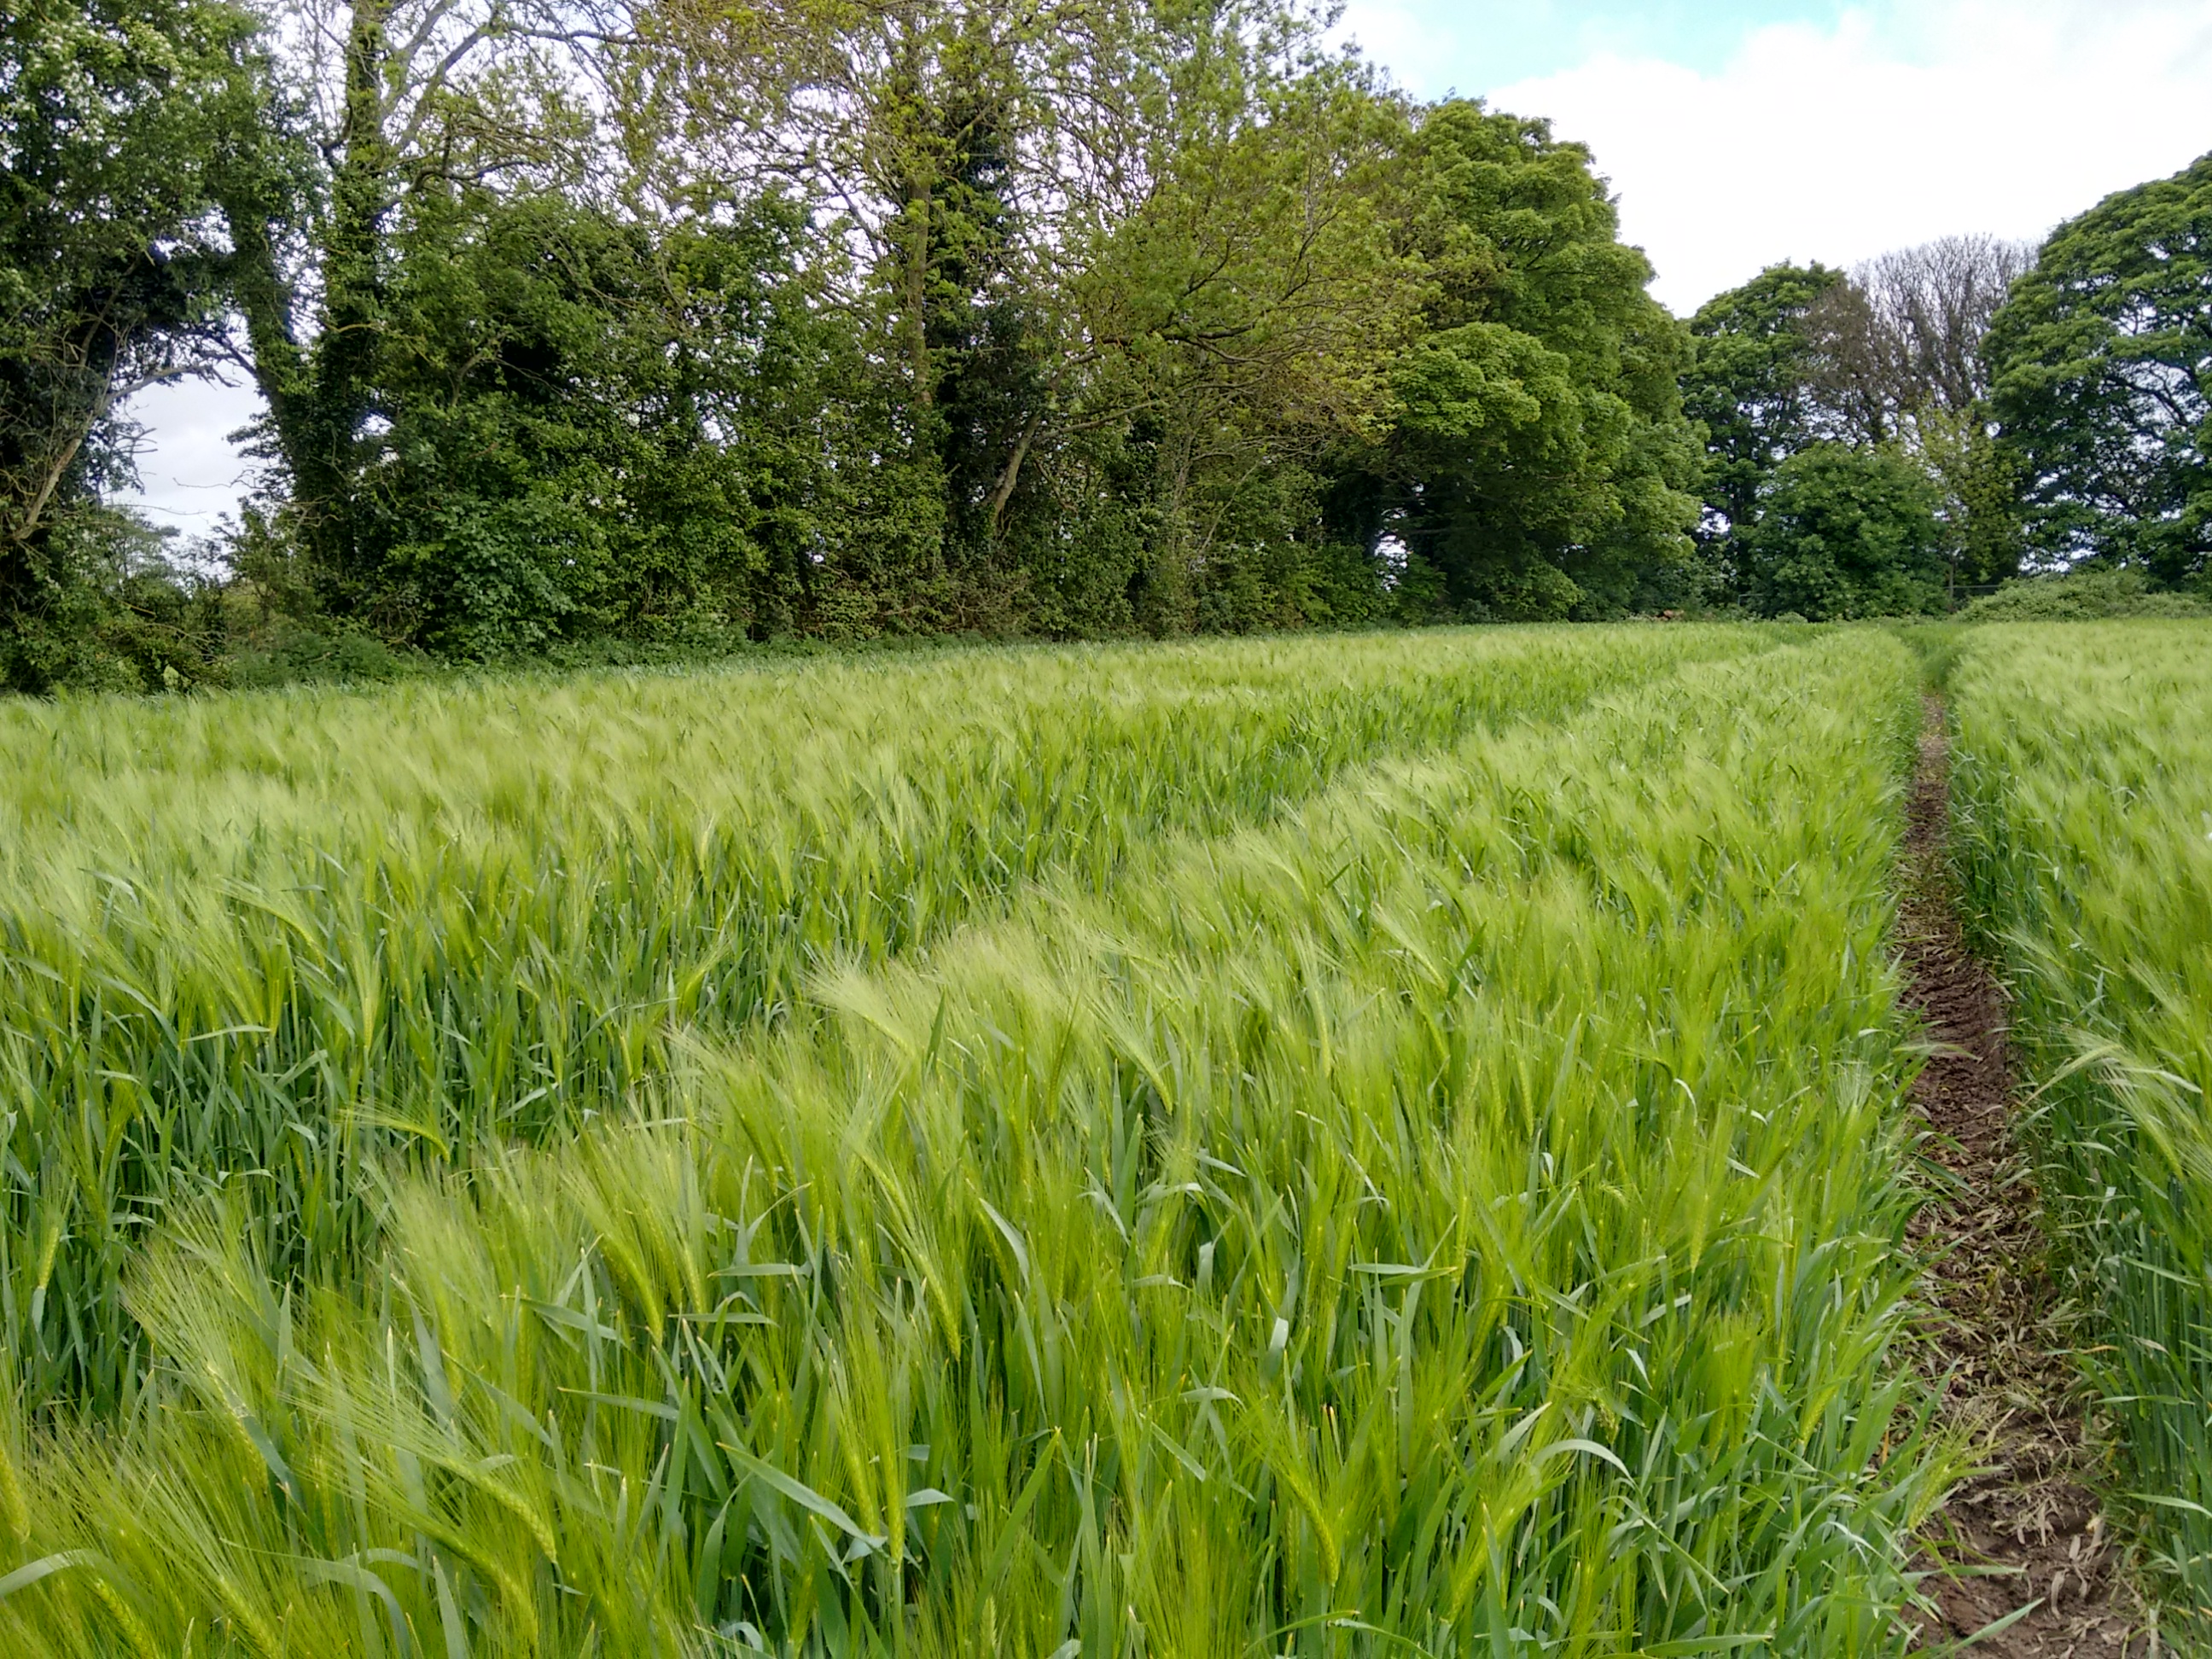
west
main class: Cropland
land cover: Barley
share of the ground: > 75 %
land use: Agriculture (excluding fallow land and kitchen gardens)
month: May
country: IE
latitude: 53.4856
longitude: -6.6637
